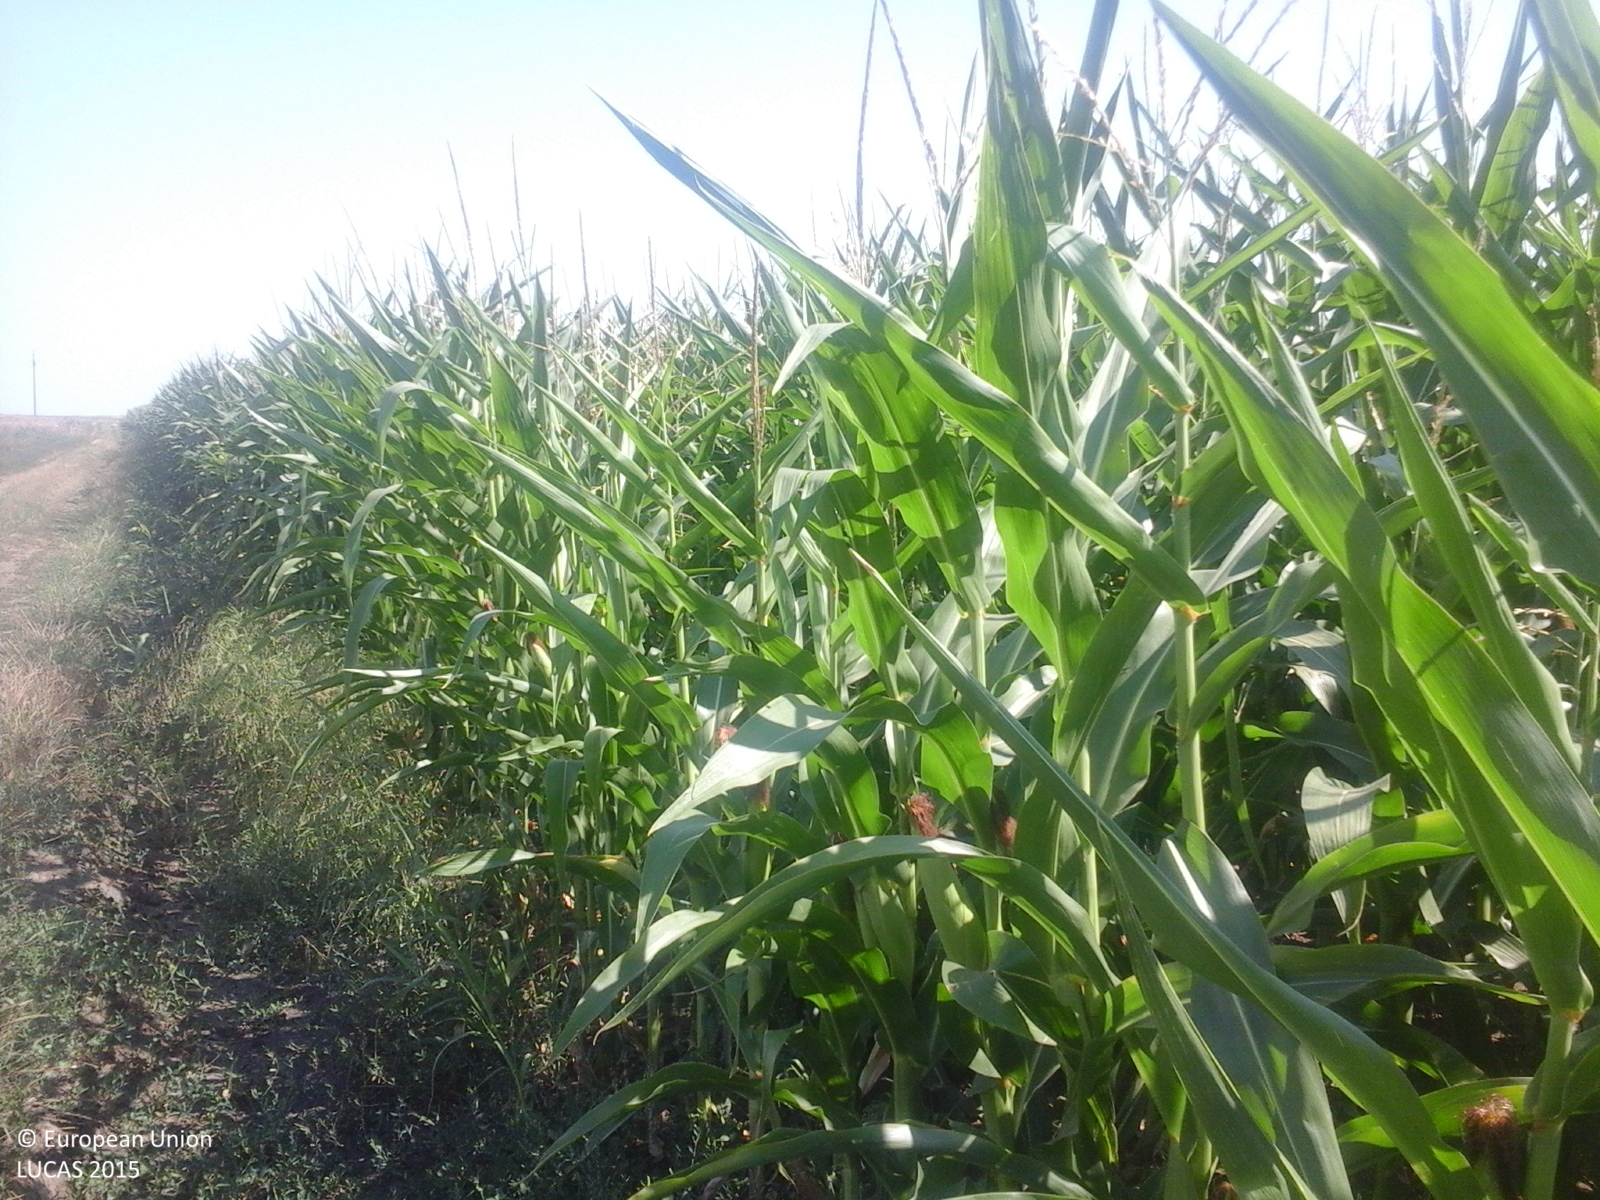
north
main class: Cropland
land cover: Maize
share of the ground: > 75 %
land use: Agriculture (excluding fallow land and kitchen gardens)
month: July
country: RO
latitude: 44.8276
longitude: 27.5648
